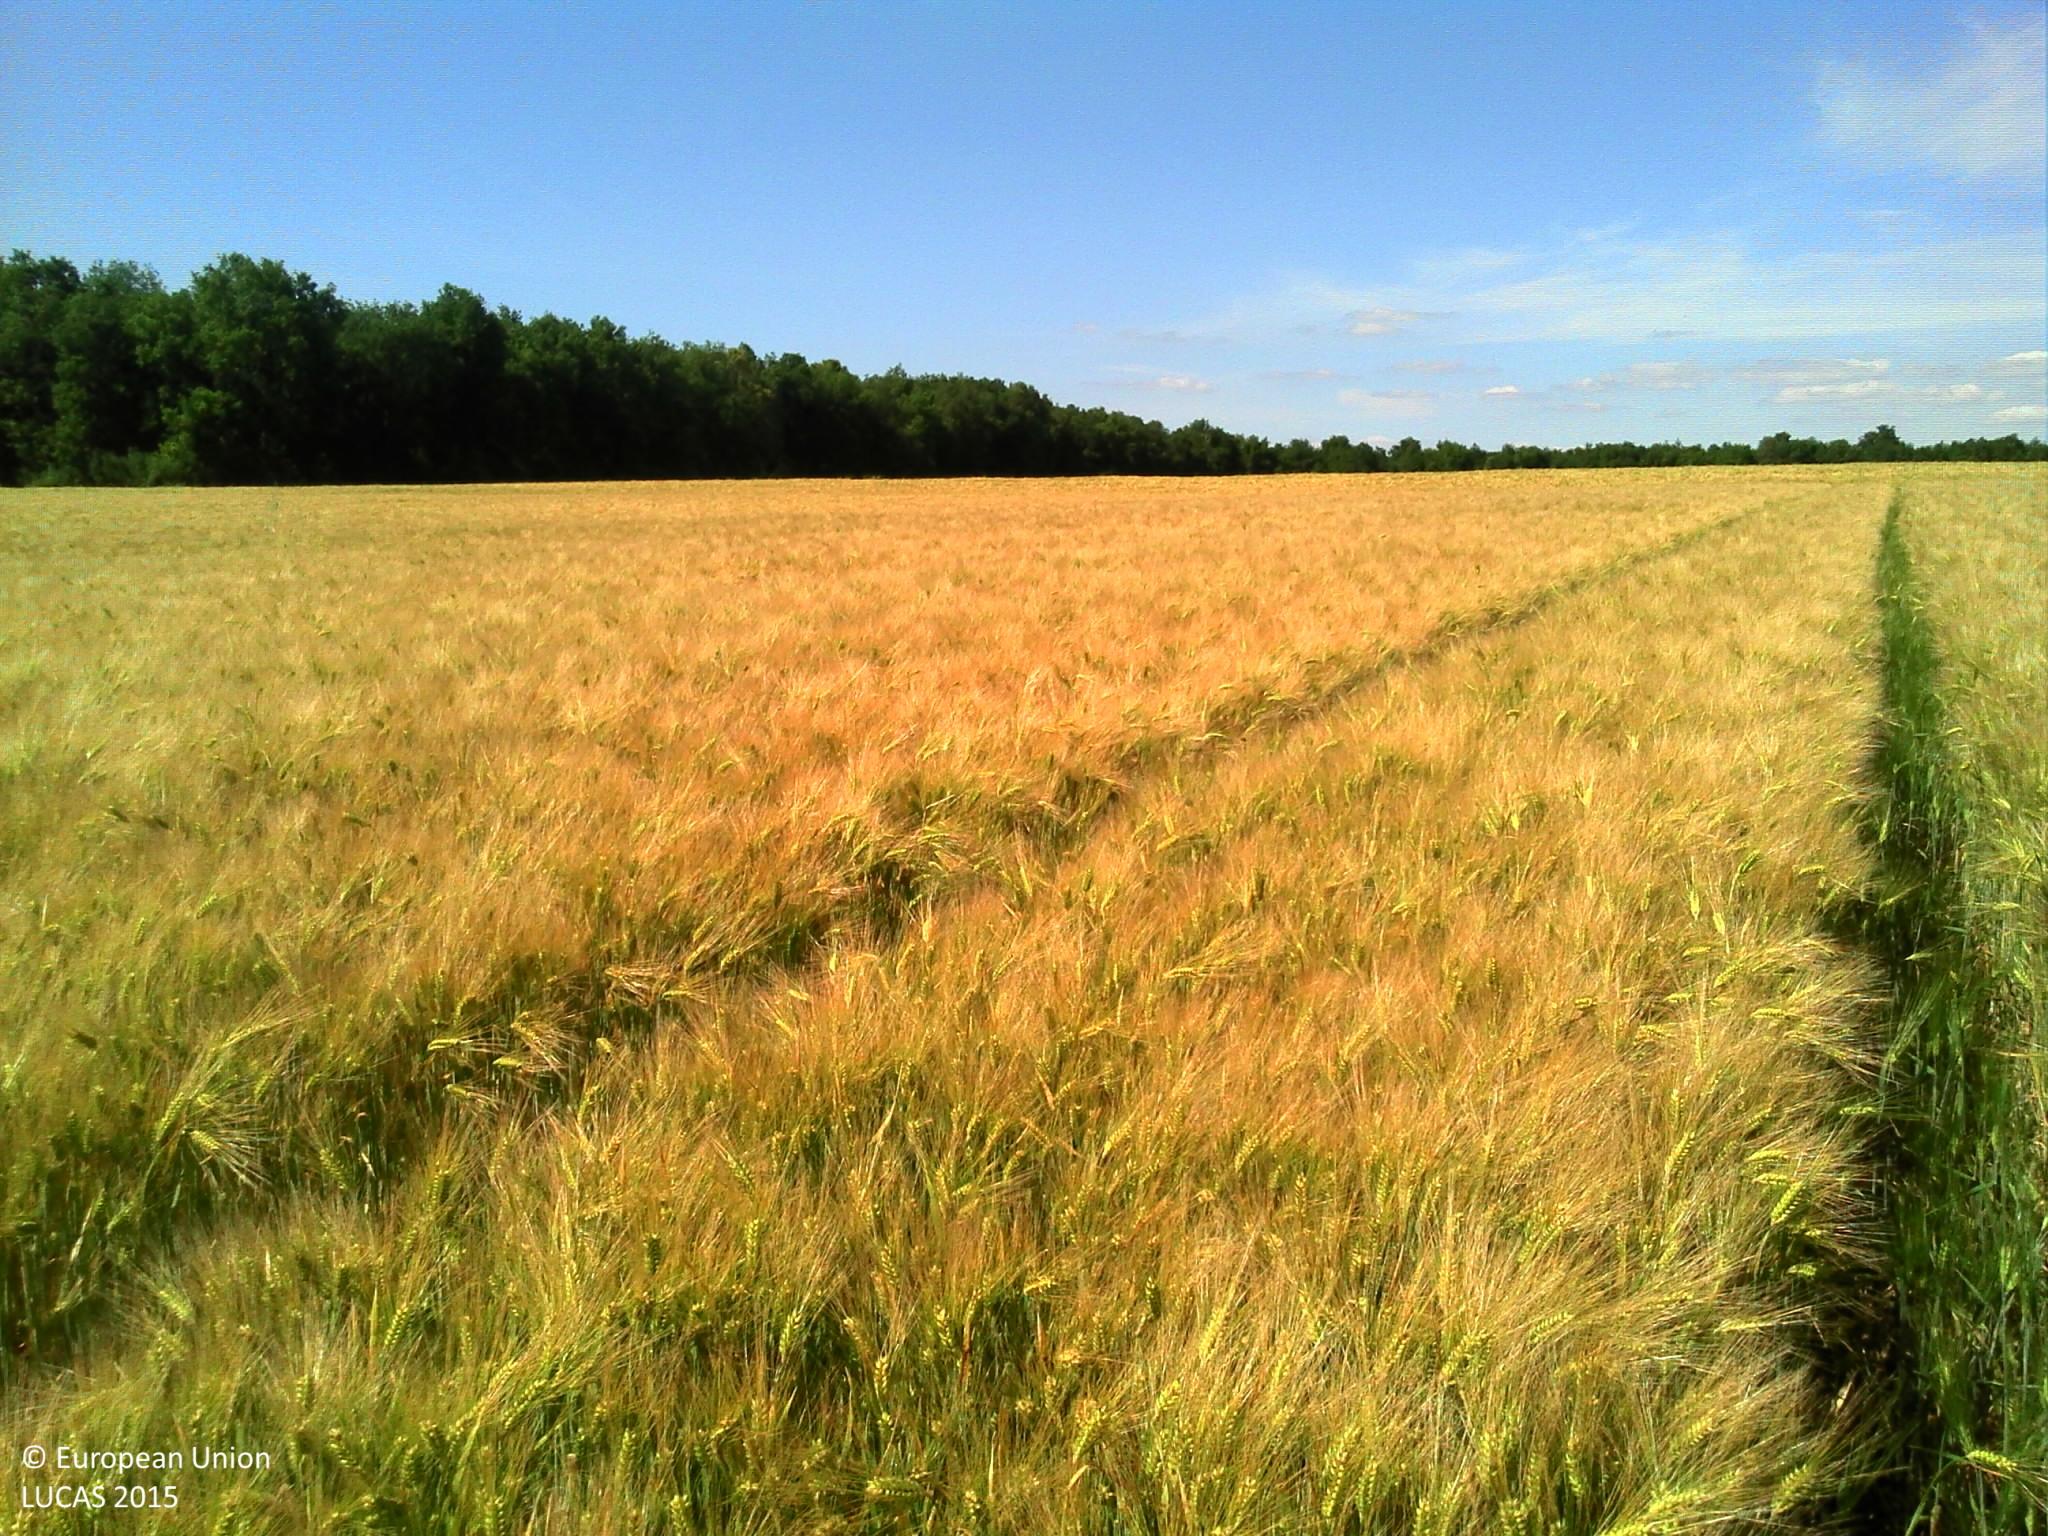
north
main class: Cropland
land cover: Barley
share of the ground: > 75 %
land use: Agriculture (excluding fallow land and kitchen gardens)
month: May
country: FR
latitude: 46.9891
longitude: 0.2087
